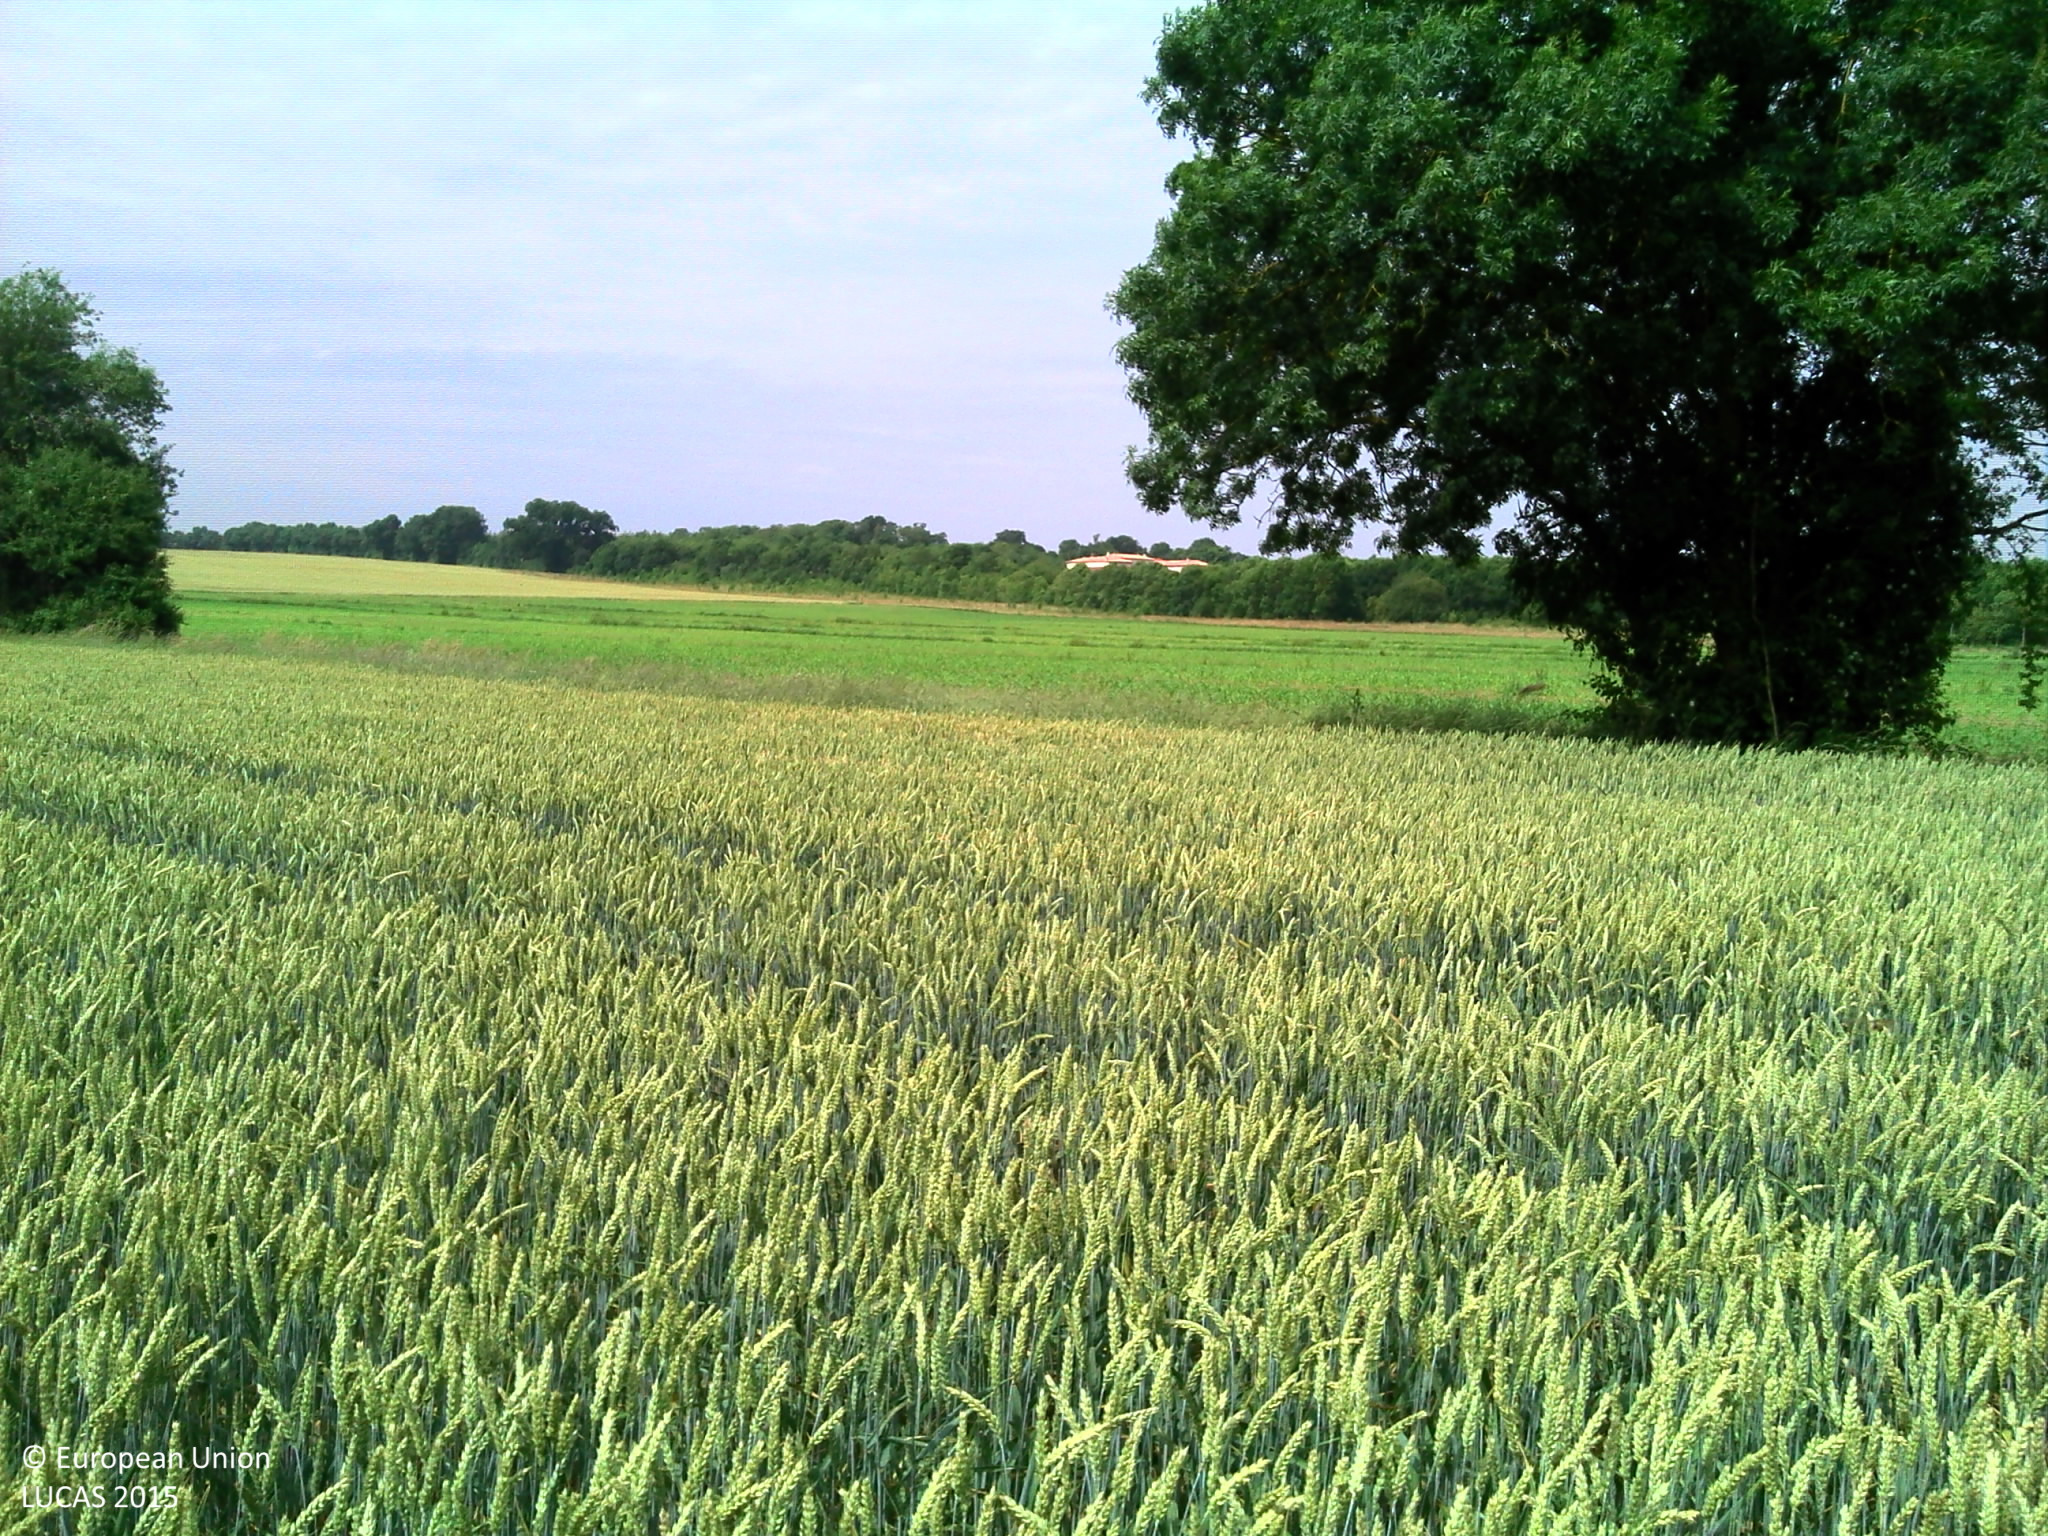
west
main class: Cropland
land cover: Durum wheat
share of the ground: > 75 %
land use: Agriculture (excluding fallow land and kitchen gardens)
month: June
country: FR
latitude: 46.0272
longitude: -0.7363
